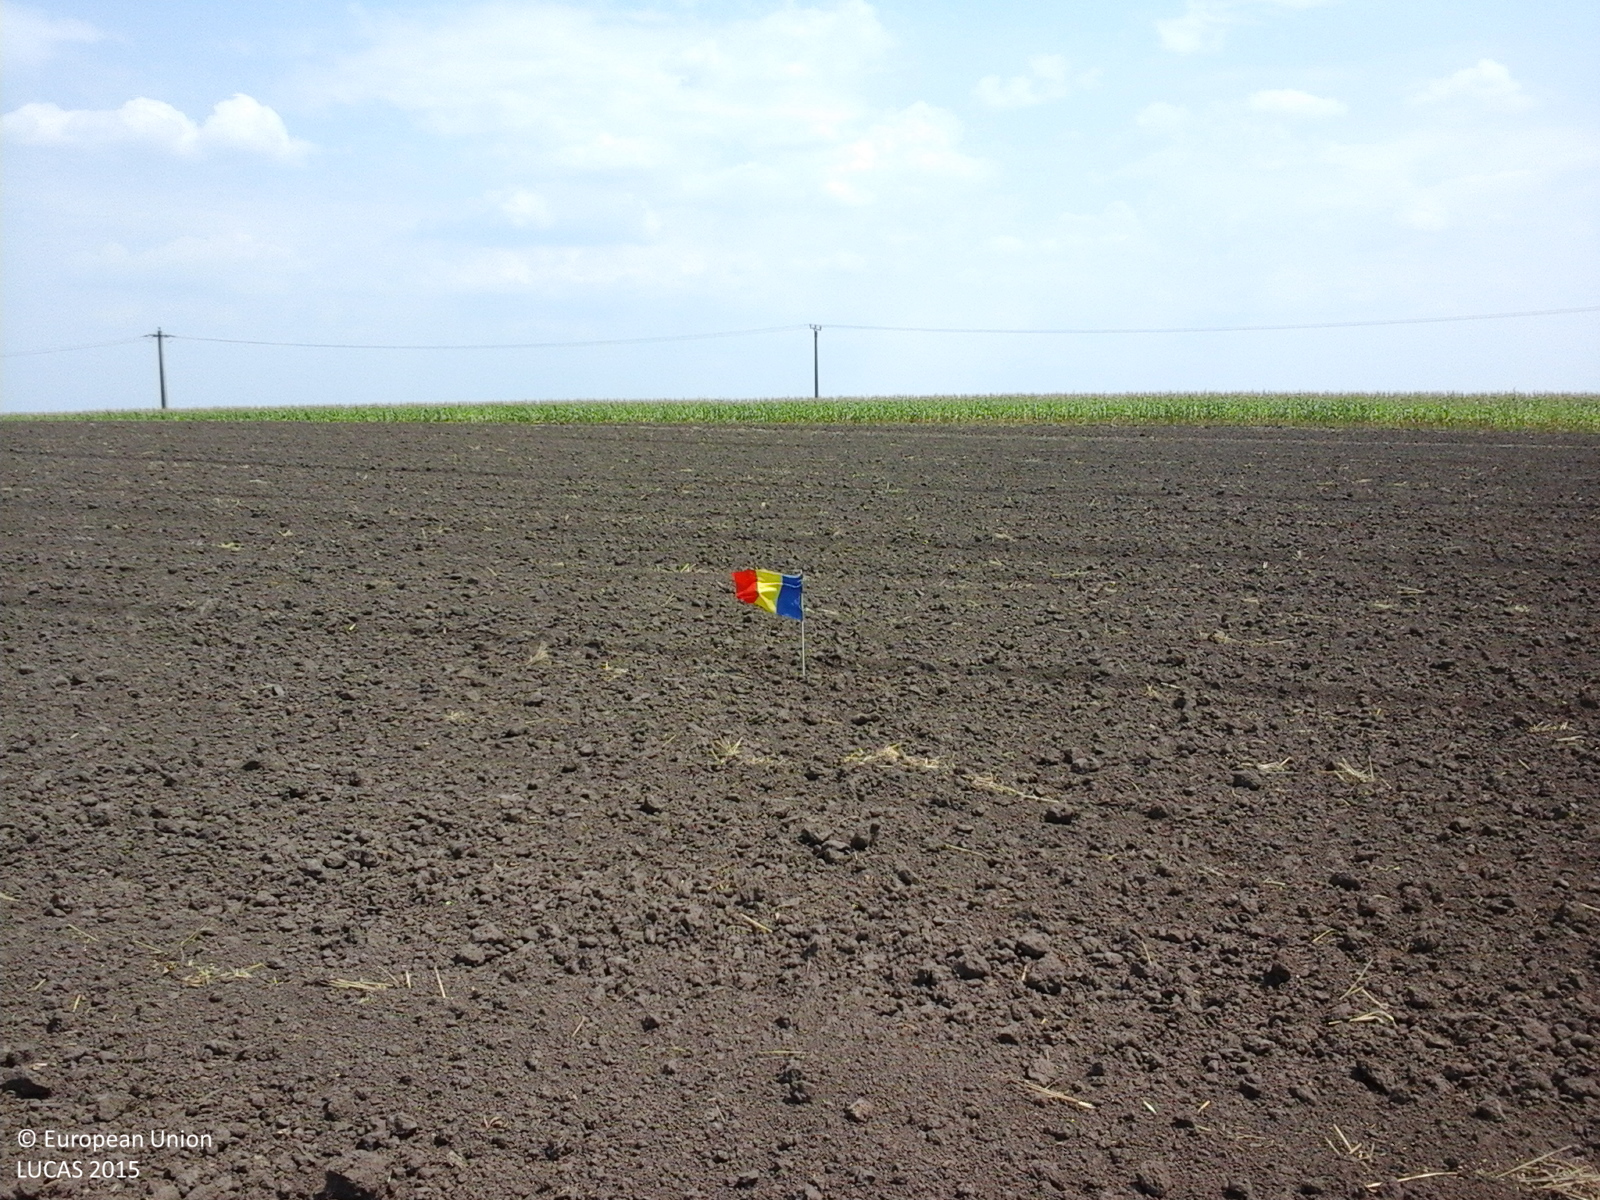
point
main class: Cropland
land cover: Common wheat
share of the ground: < 10 %
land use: Agriculture (excluding fallow land and kitchen gardens)
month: July
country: RO
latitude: 45.8858
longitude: 27.5151
